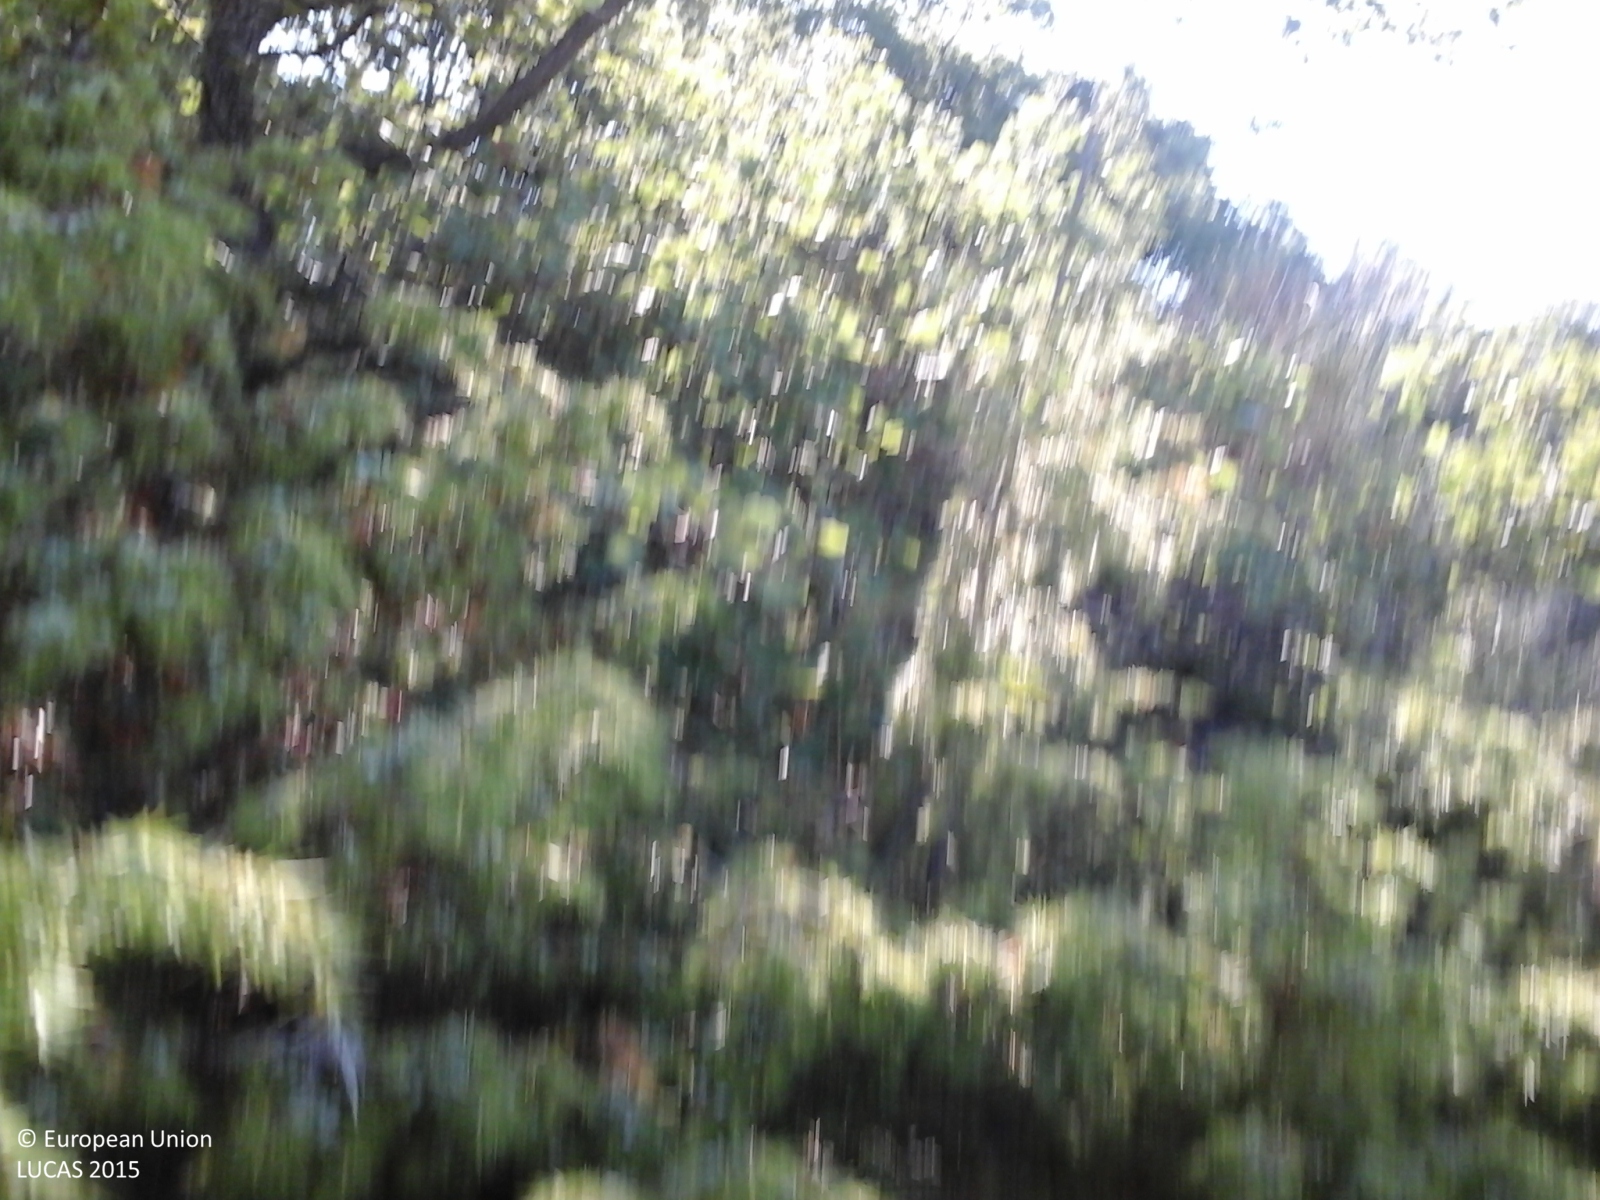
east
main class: Woodland
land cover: Broadleaved woodland
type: thermophilous deciduous forest
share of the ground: > 75 %
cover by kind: broadleaved forest trees 70 %, shrubs 20 %, herbaceous plants 10 %
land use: Semi-natural and natural areas not in use
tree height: < 5 m
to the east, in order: Broadleaved woodland; Shrubland with sparse tree cover; Groves
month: August
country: IT
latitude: 42.9480
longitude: 11.6250
